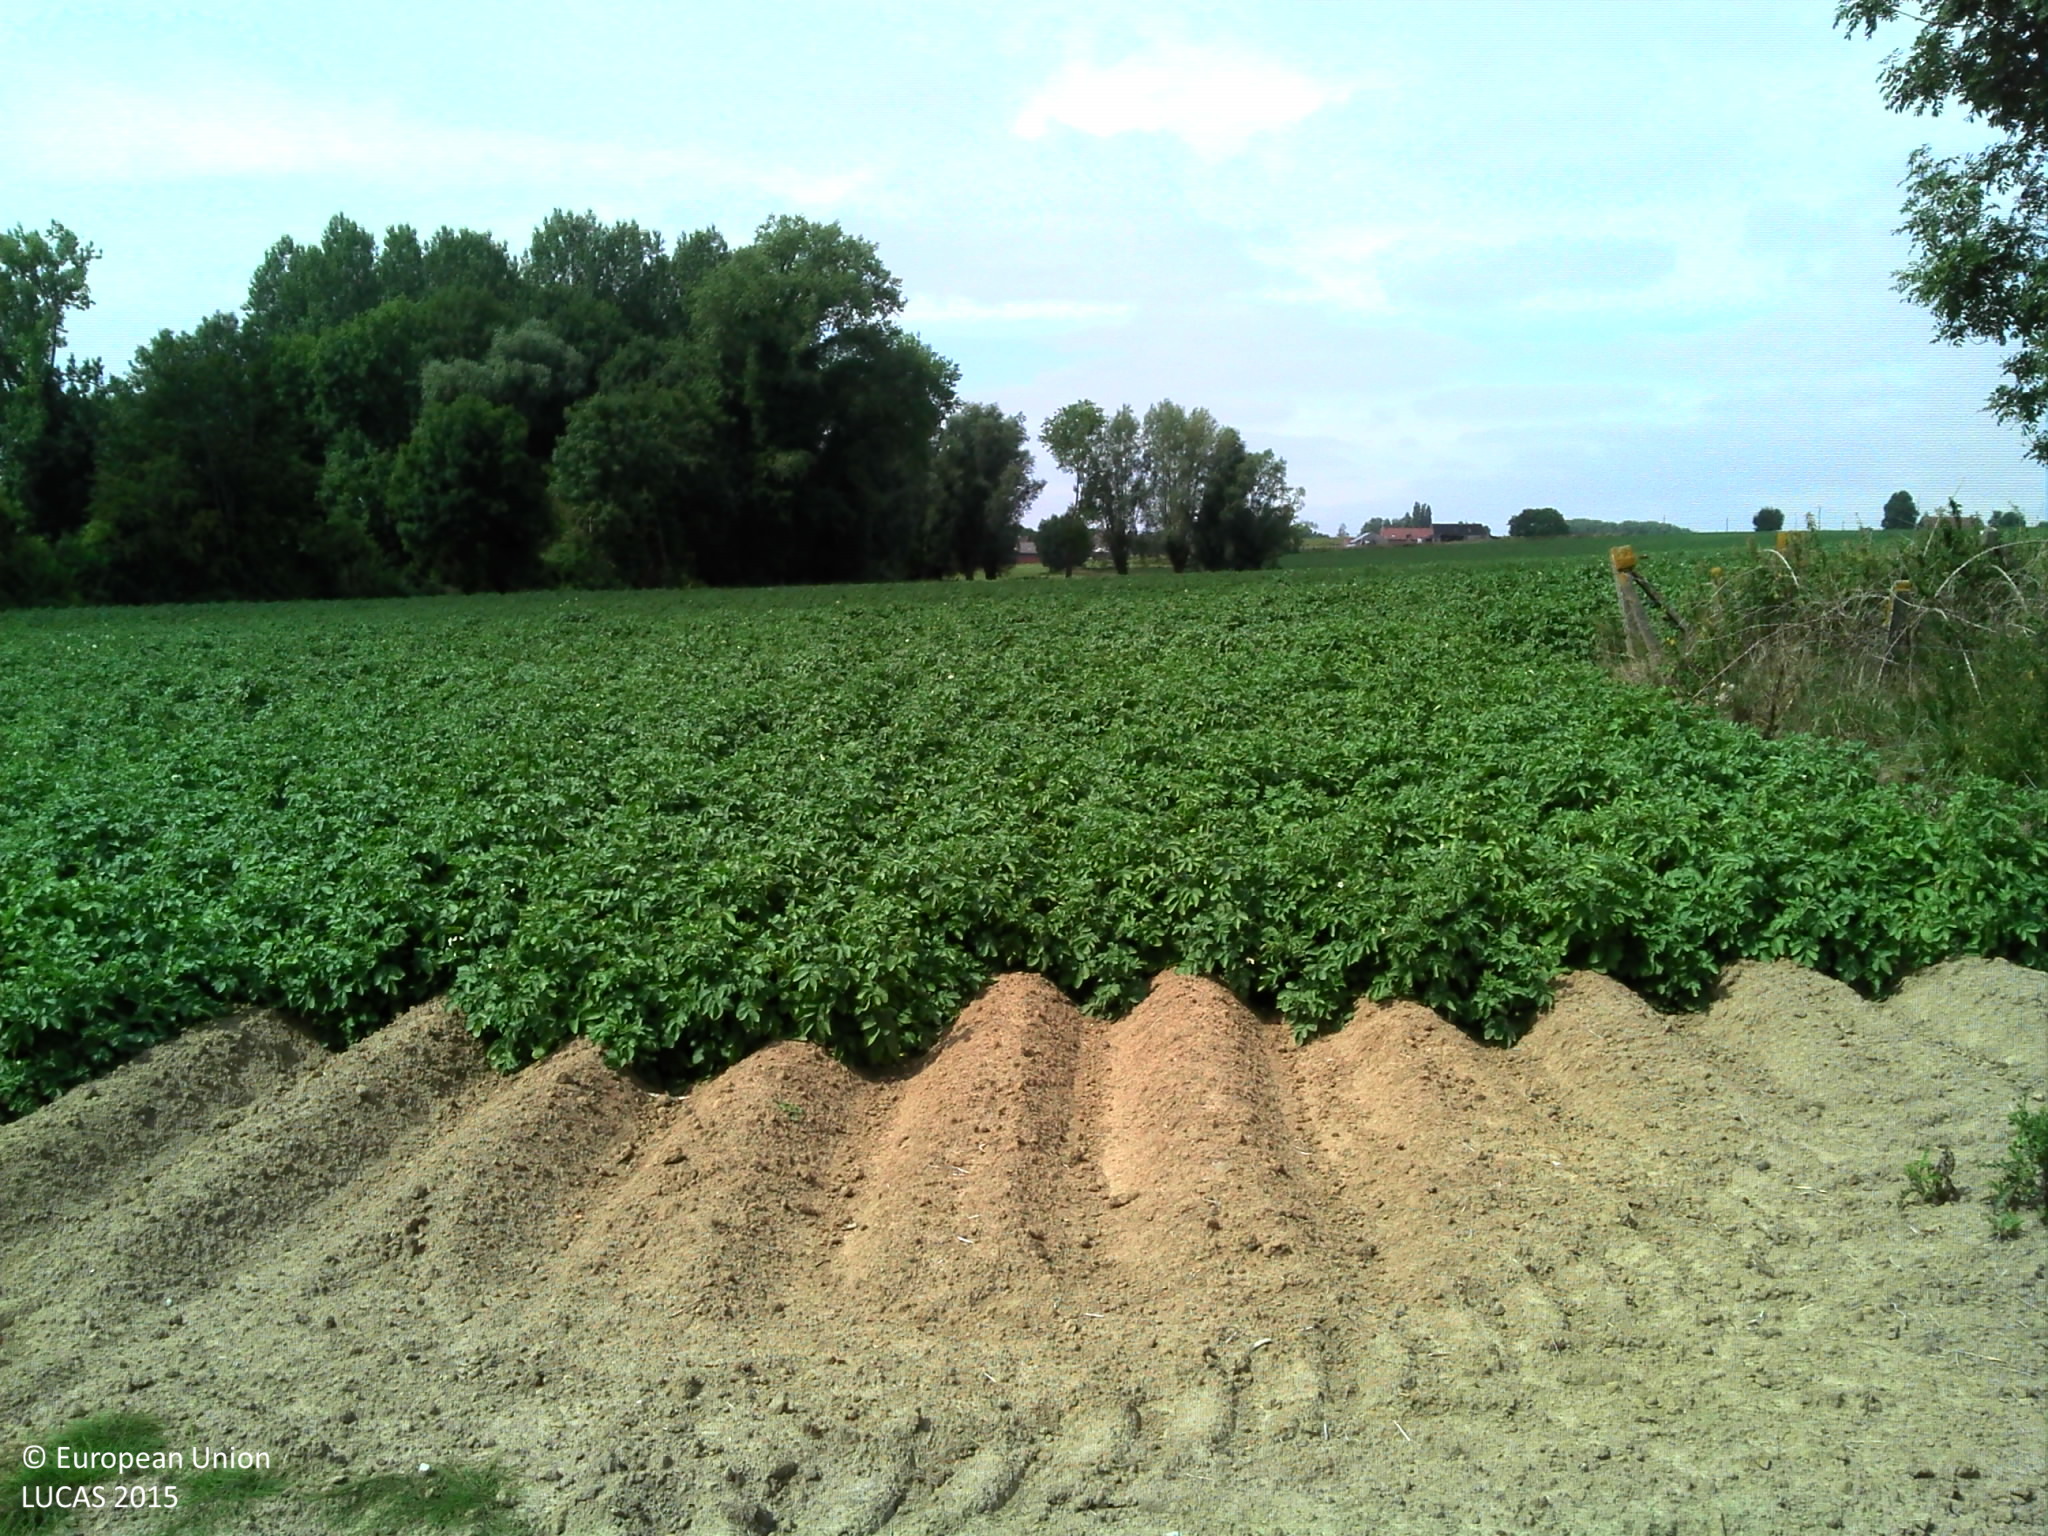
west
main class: Cropland
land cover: Potatoes
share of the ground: > 75 %
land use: Agriculture (excluding fallow land and kitchen gardens)
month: August
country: BE
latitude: 50.7370
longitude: 3.8013
